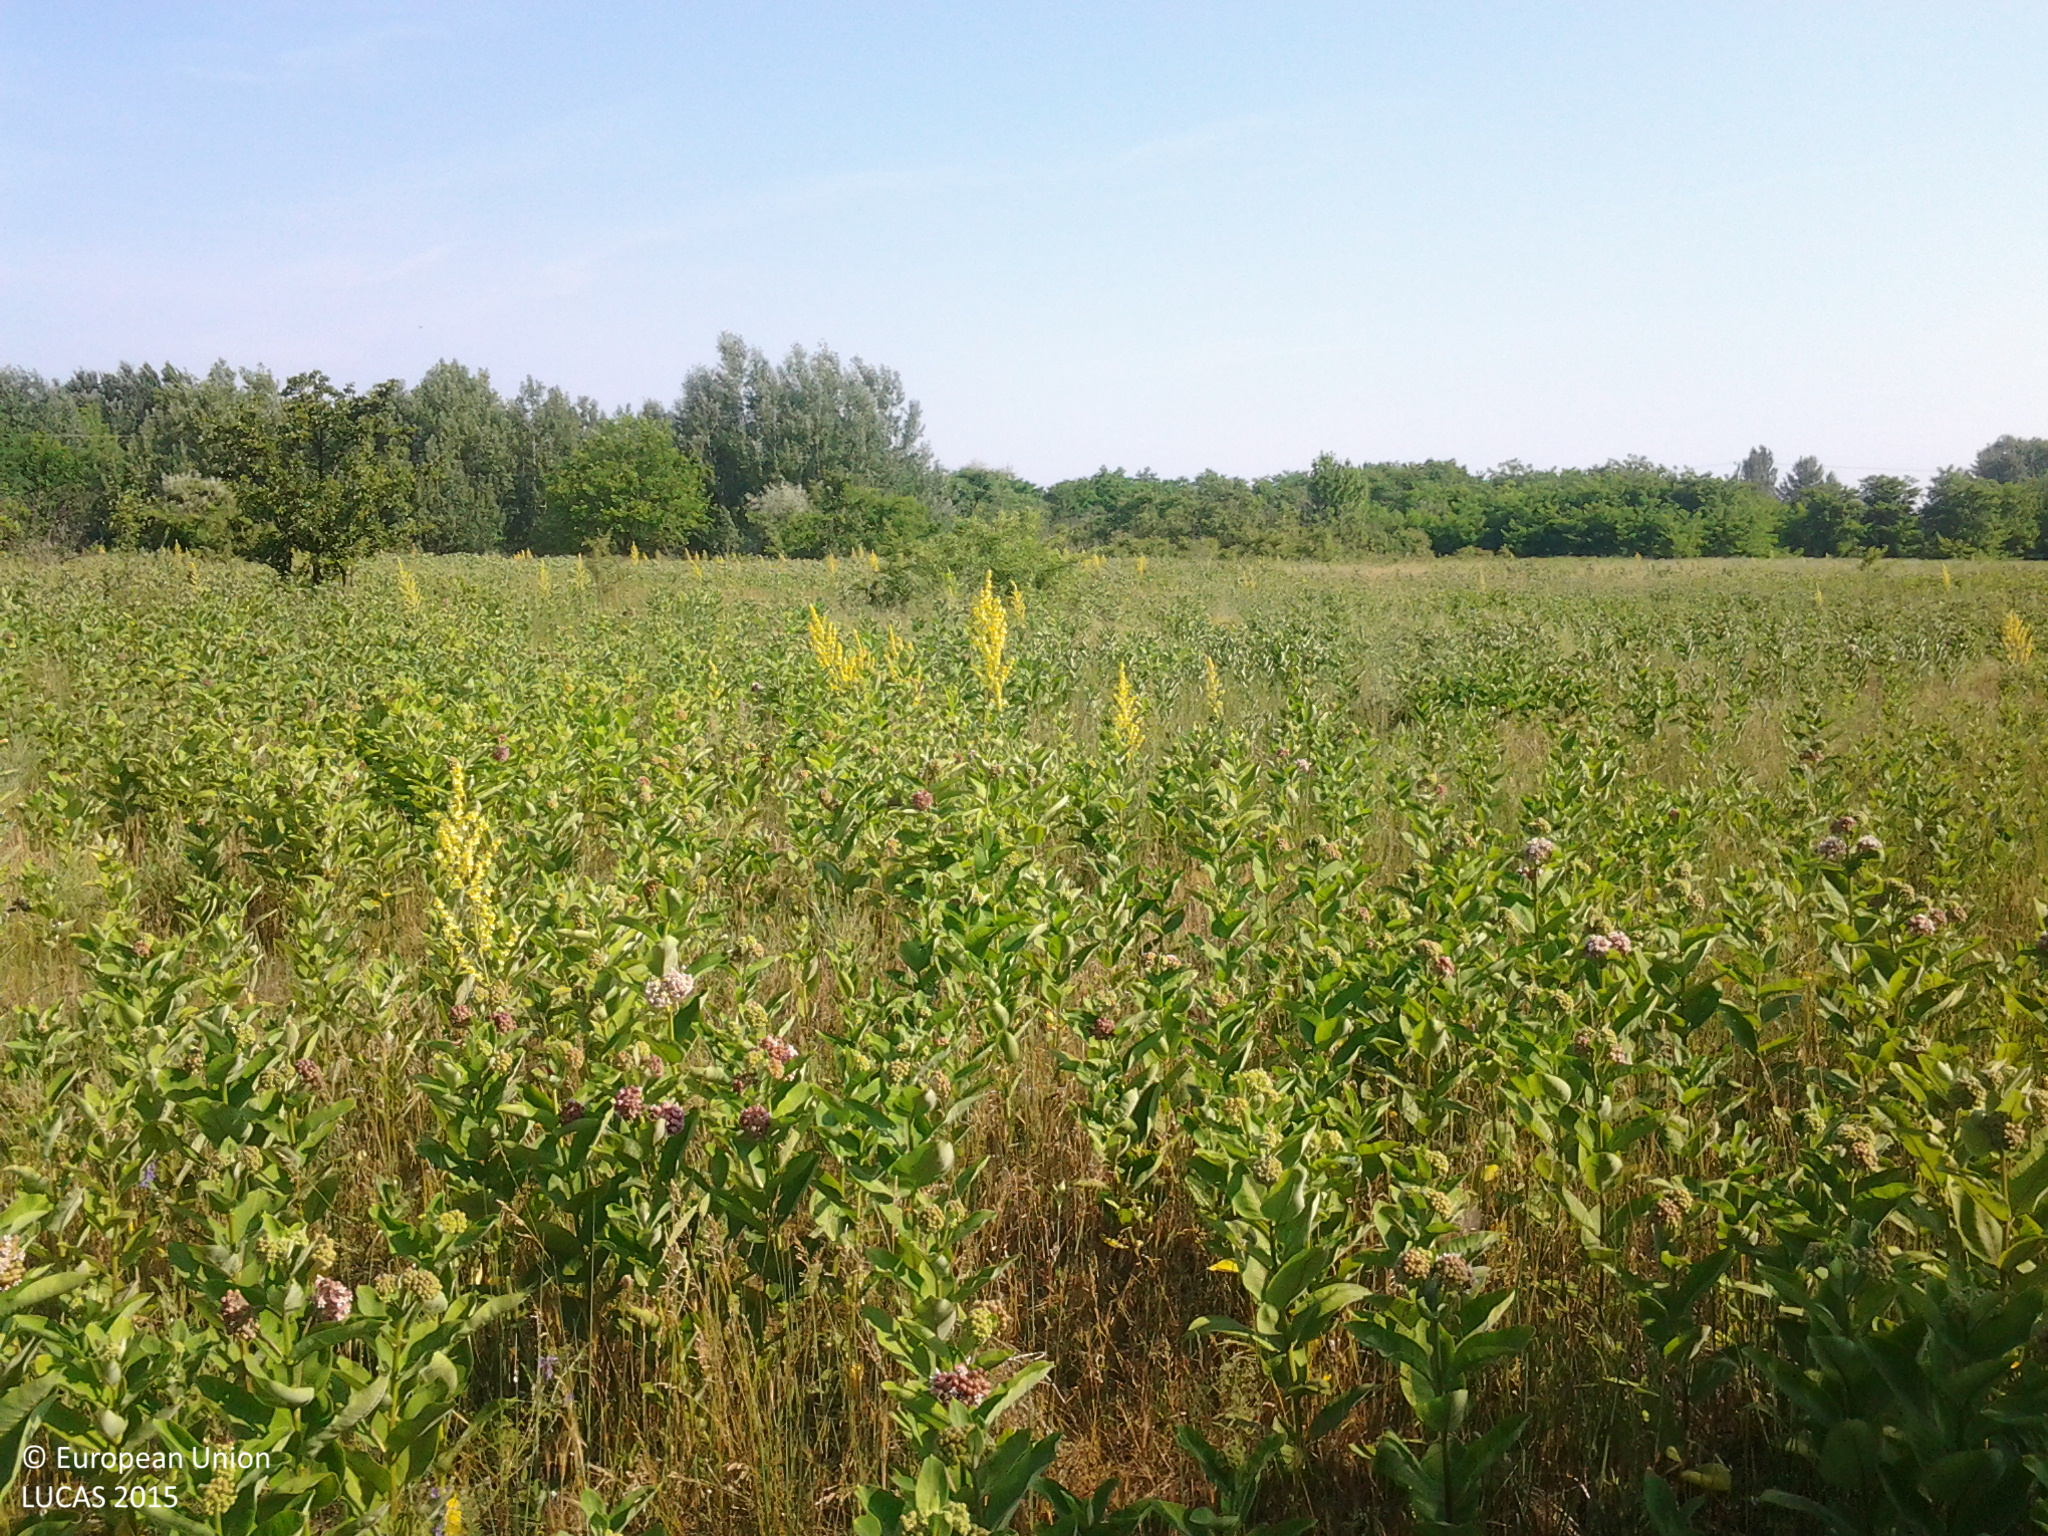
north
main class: Grassland
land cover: Spontaneously vegetated surfaces
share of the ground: > 75 %
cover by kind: herbaceous plants 100 %
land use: Semi-natural and natural areas not in use
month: June
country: HU
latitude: 46.8605
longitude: 19.6084
